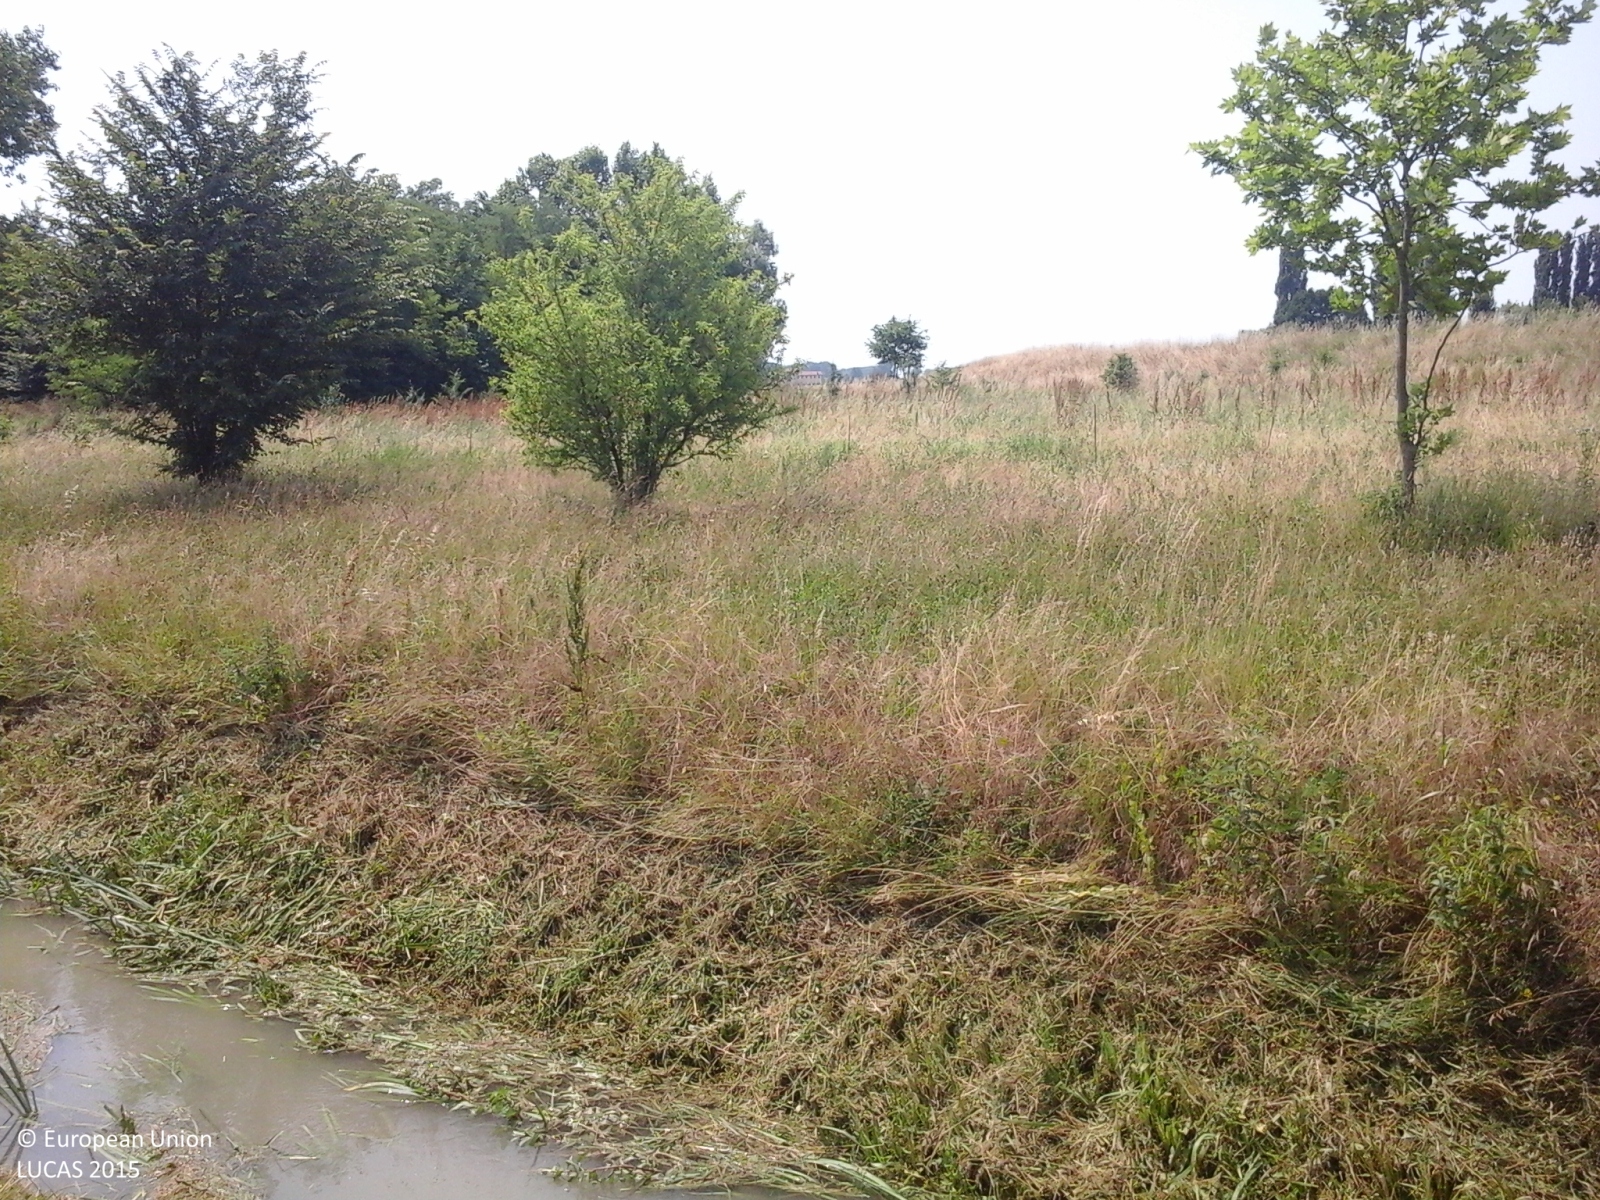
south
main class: Grassland
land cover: Grassland with sparse tree/shrub cover
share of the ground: > 75 %
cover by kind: herbaceous plants 95 %, broadleaved forest trees 5 %
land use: Agriculture (excluding fallow land and kitchen gardens)
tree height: < 5 m
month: June
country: IT
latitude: 45.6023
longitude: 12.4452
